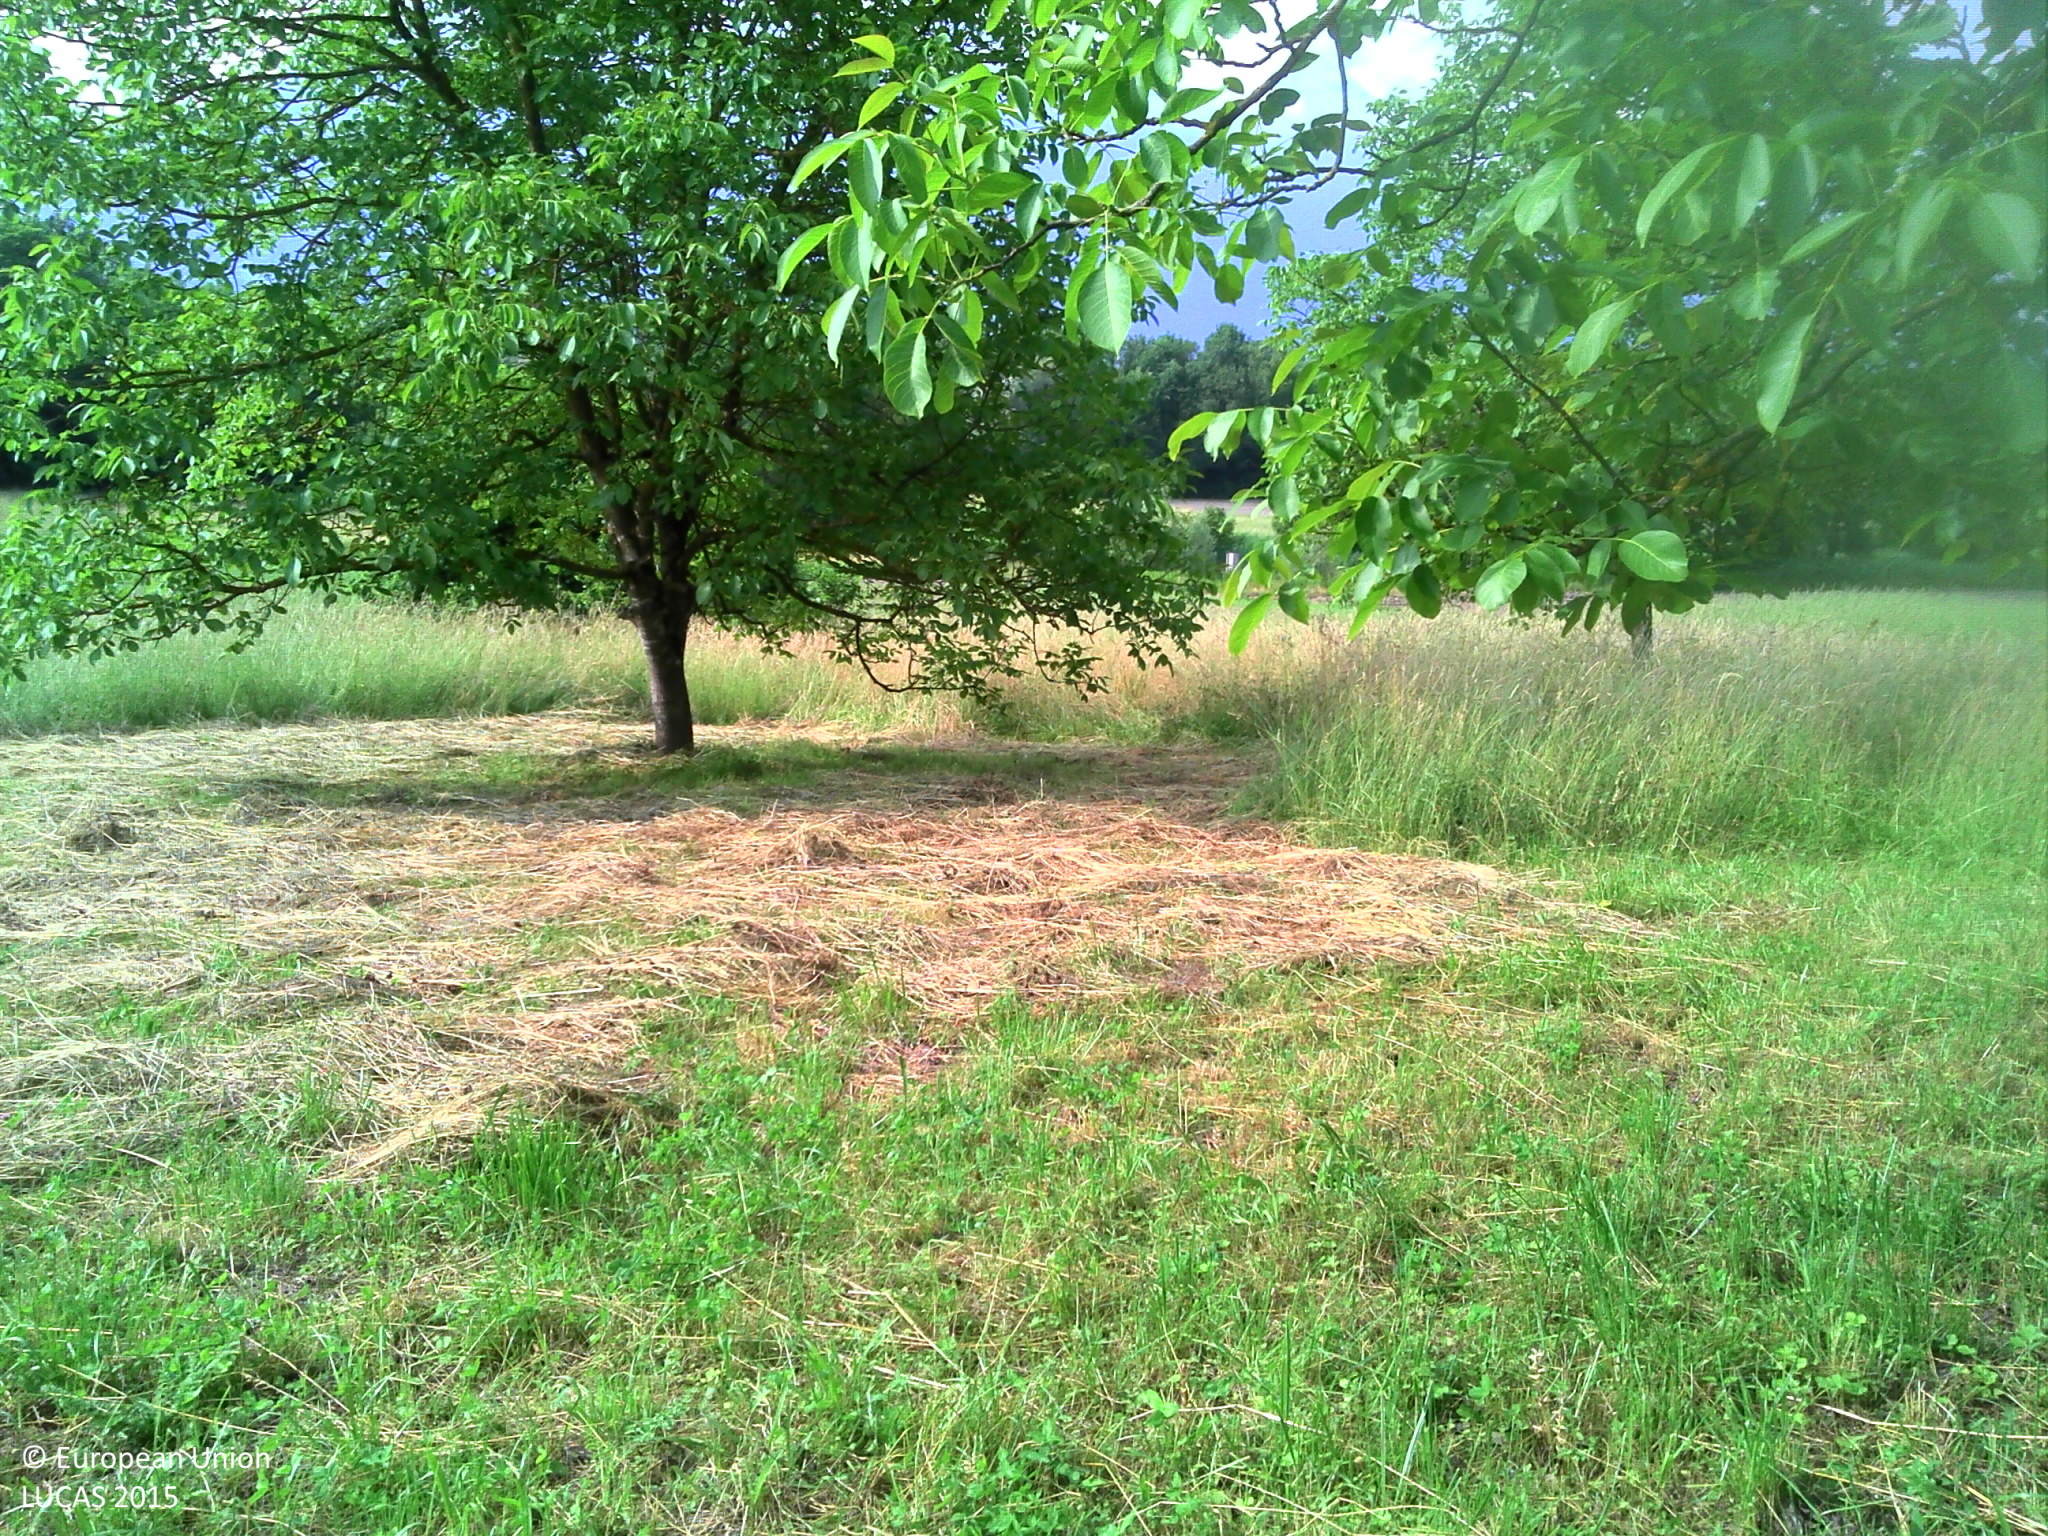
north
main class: Cropland
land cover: Nuts trees
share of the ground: < 10 %
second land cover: Grassland without tree/shrub cover
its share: > 75 %
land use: Agriculture (excluding fallow land and kitchen gardens)
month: June
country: FR
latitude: 45.5263
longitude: 6.2020
